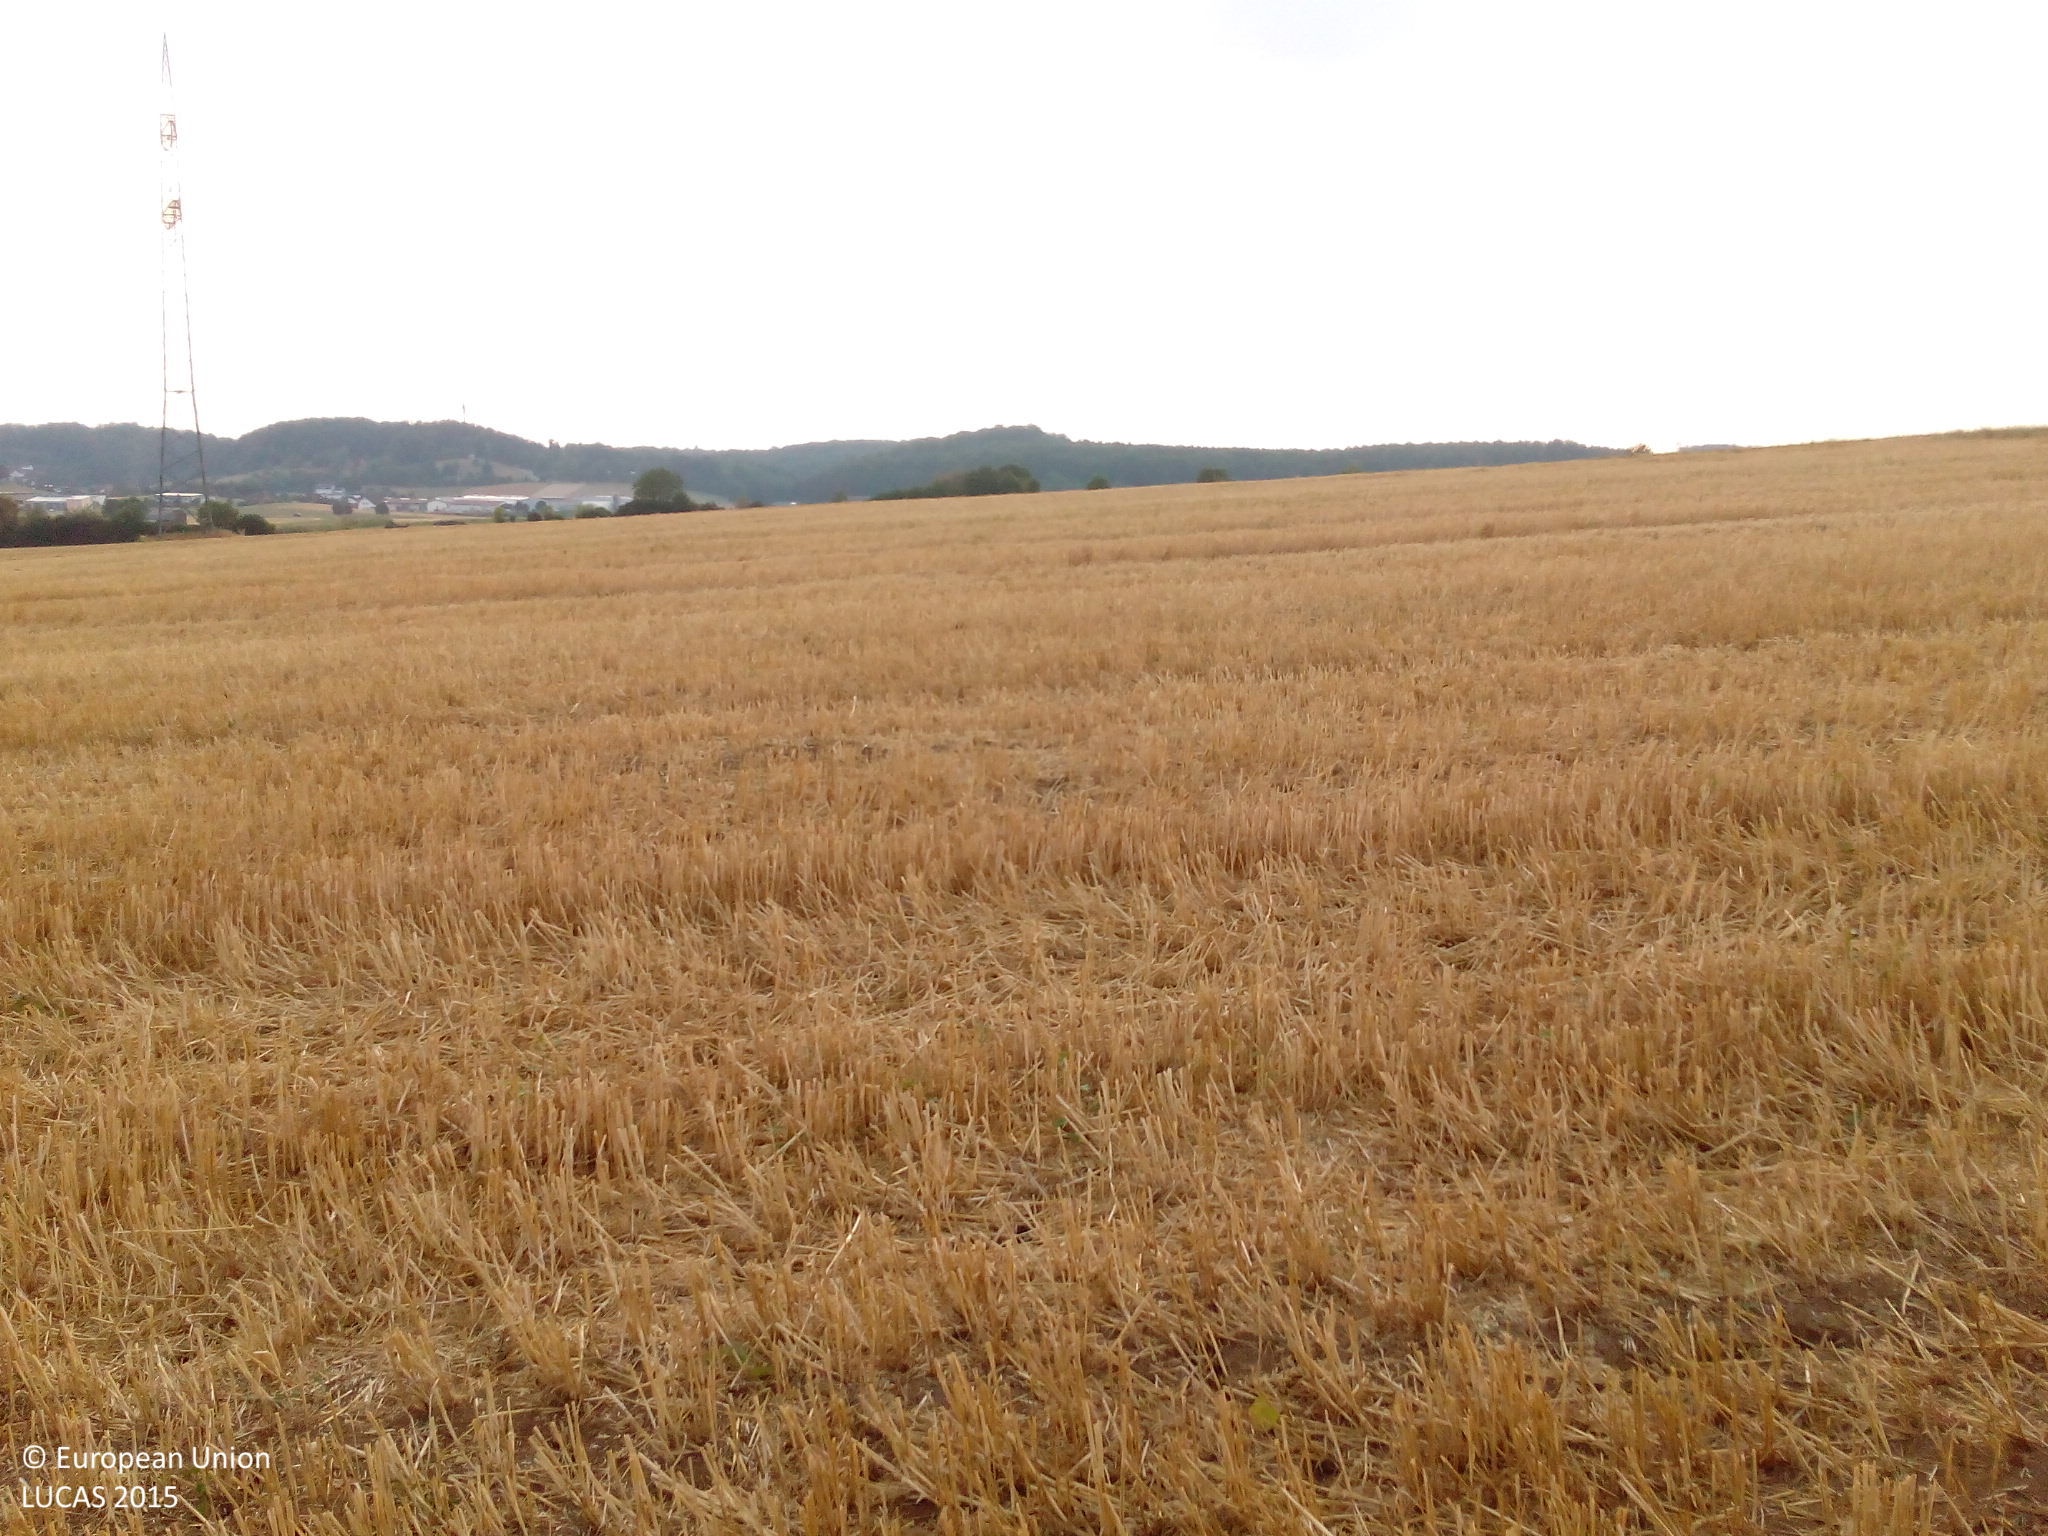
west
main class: Cropland
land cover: Common wheat
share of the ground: > 75 %
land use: Agriculture (excluding fallow land and kitchen gardens)
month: August
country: DE
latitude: 48.7090
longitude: 10.2581
